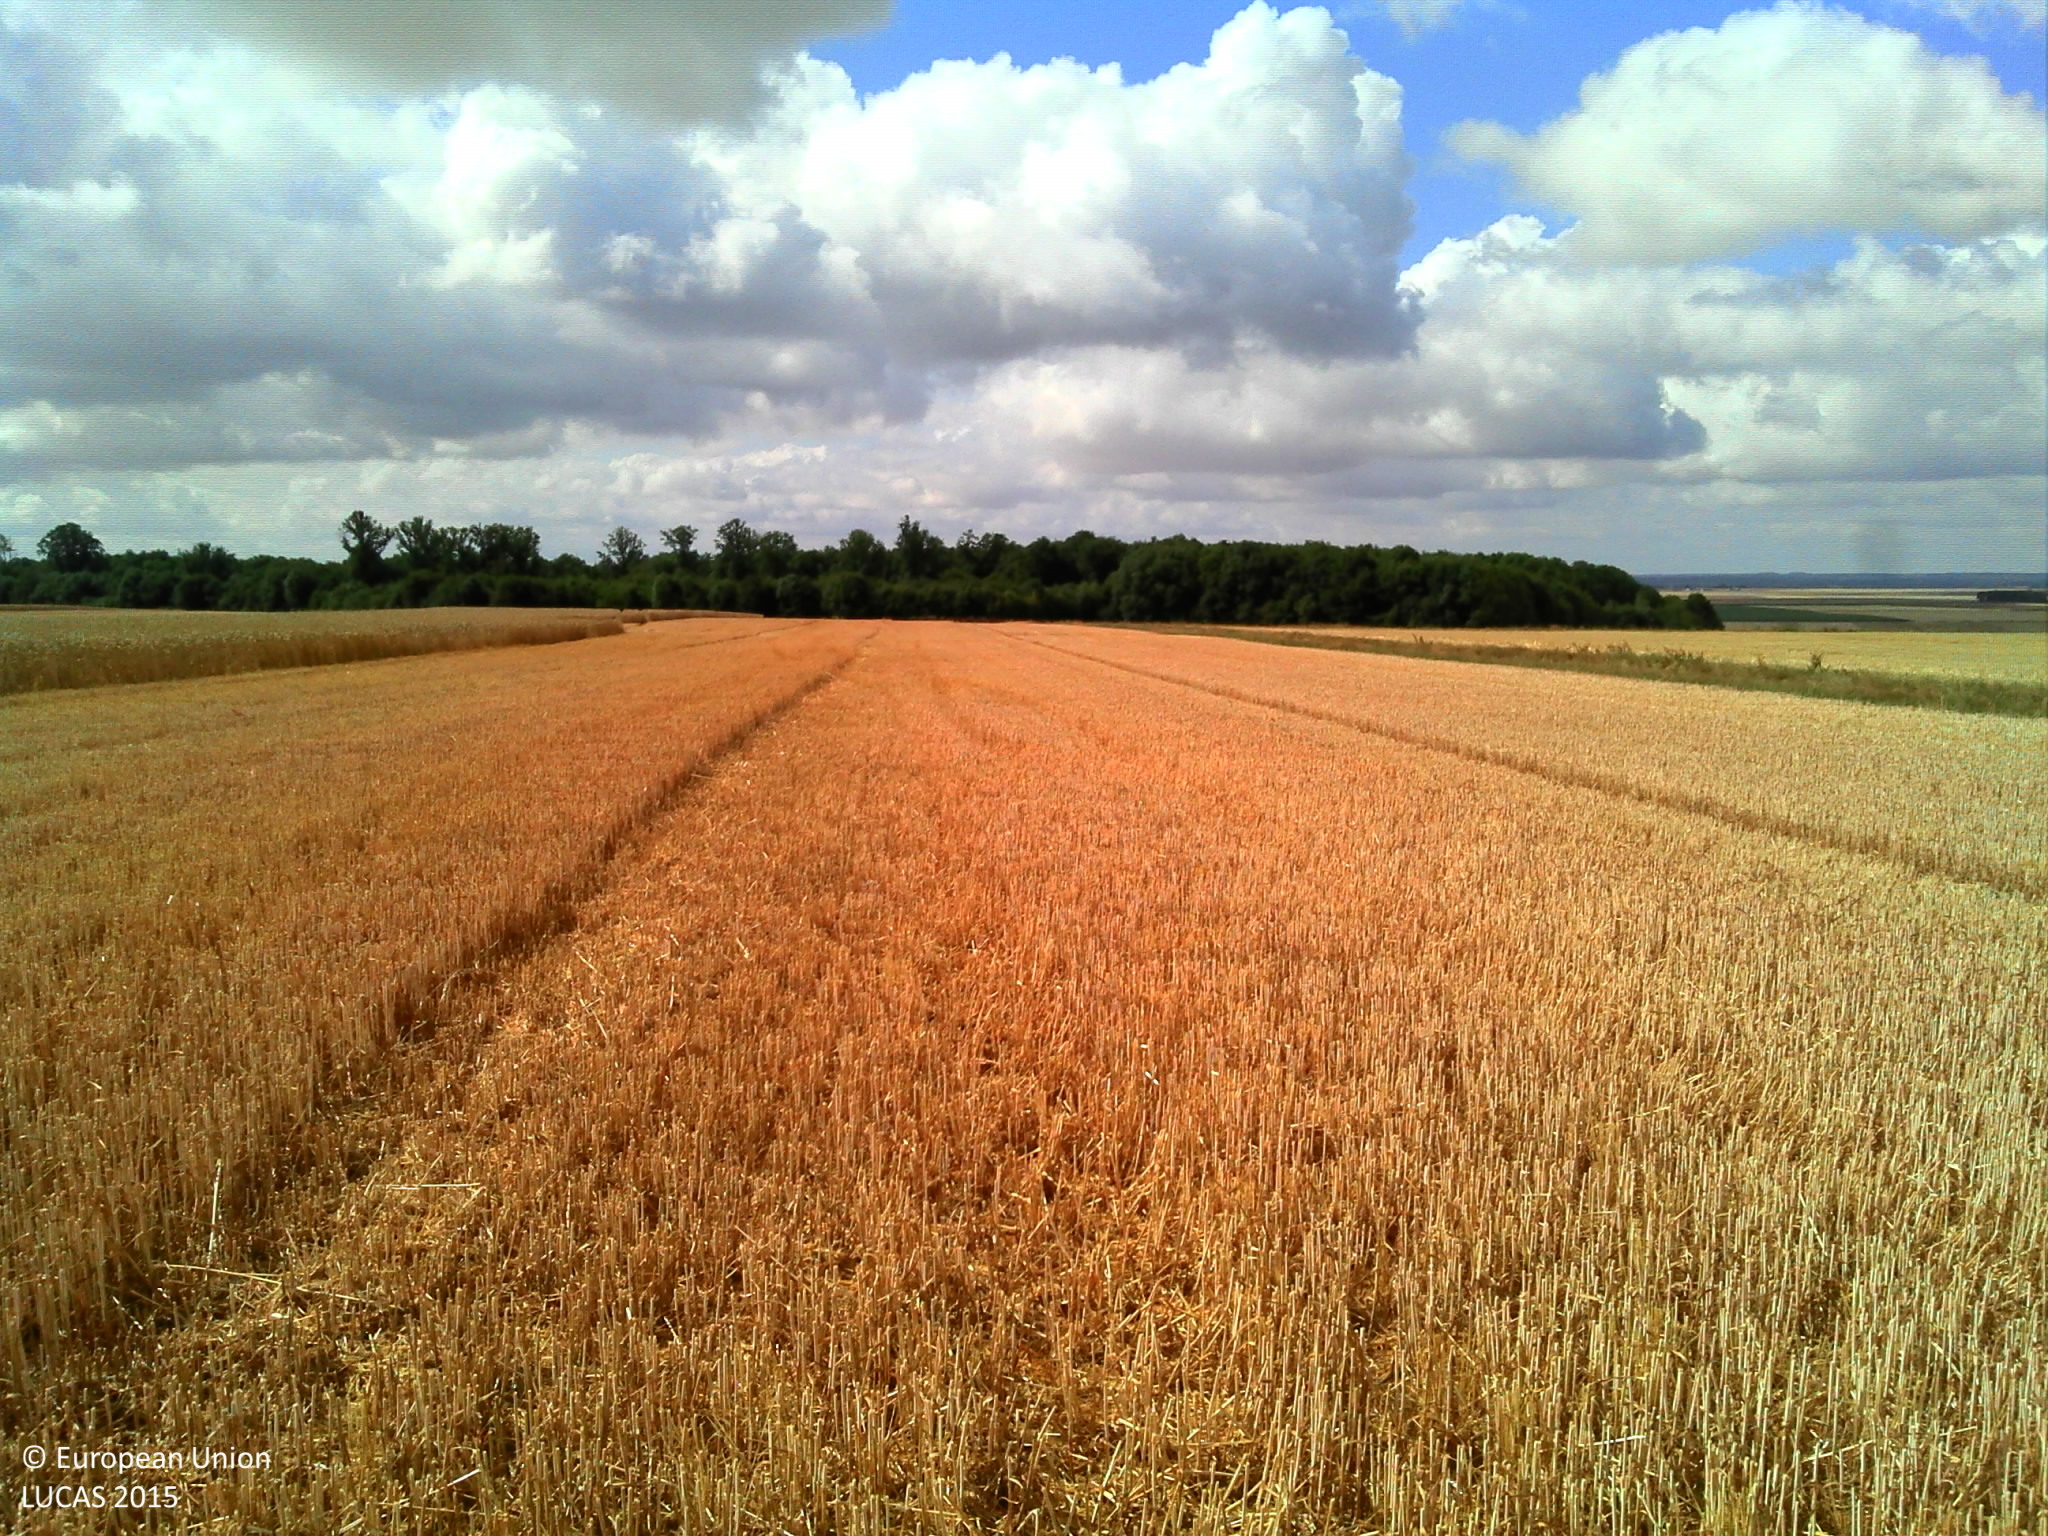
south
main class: Cropland
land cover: Common wheat
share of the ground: > 75 %
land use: Agriculture (excluding fallow land and kitchen gardens)
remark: Harvested field
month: July
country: FR
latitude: 48.5243
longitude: 1.2206
